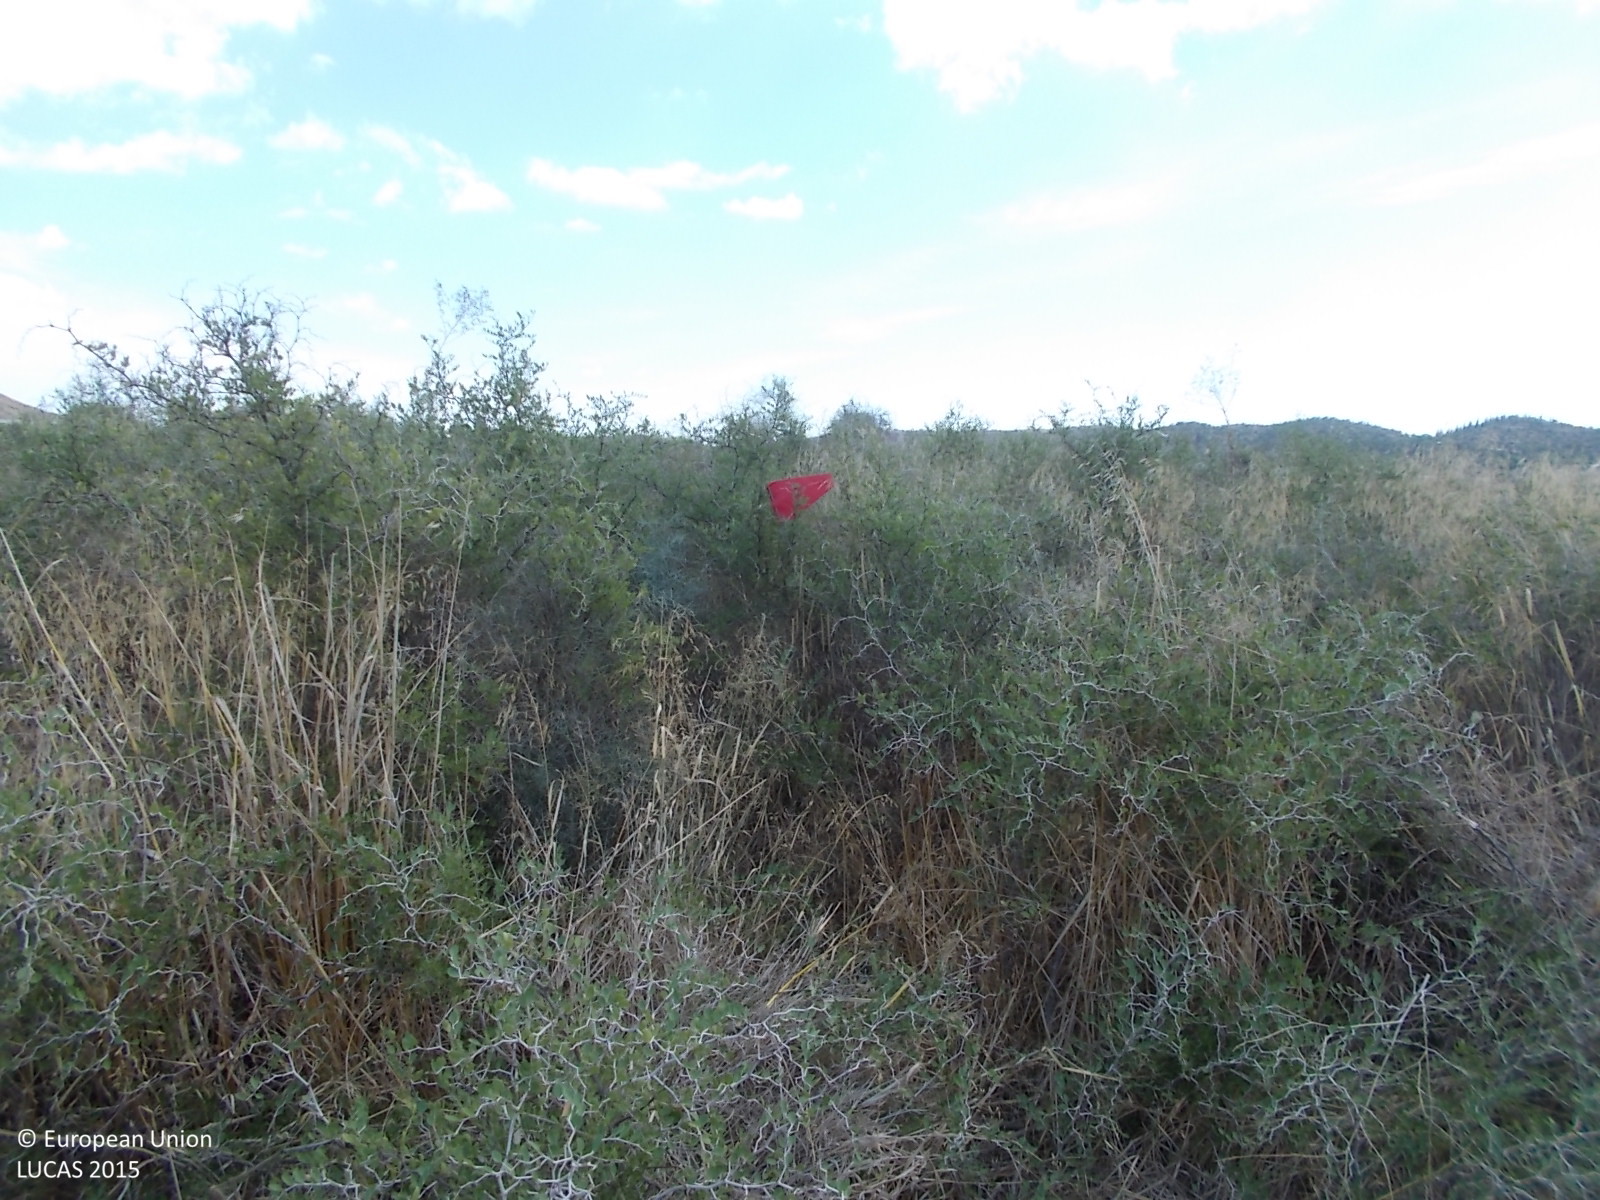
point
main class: Shrubland
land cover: Shrubland without tree cover
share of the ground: > 75 %
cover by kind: shrubs 60 %, herbaceous plants 40 %
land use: Semi-natural and natural areas not in use
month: April
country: CY
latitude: 35.0182
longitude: 33.3678
